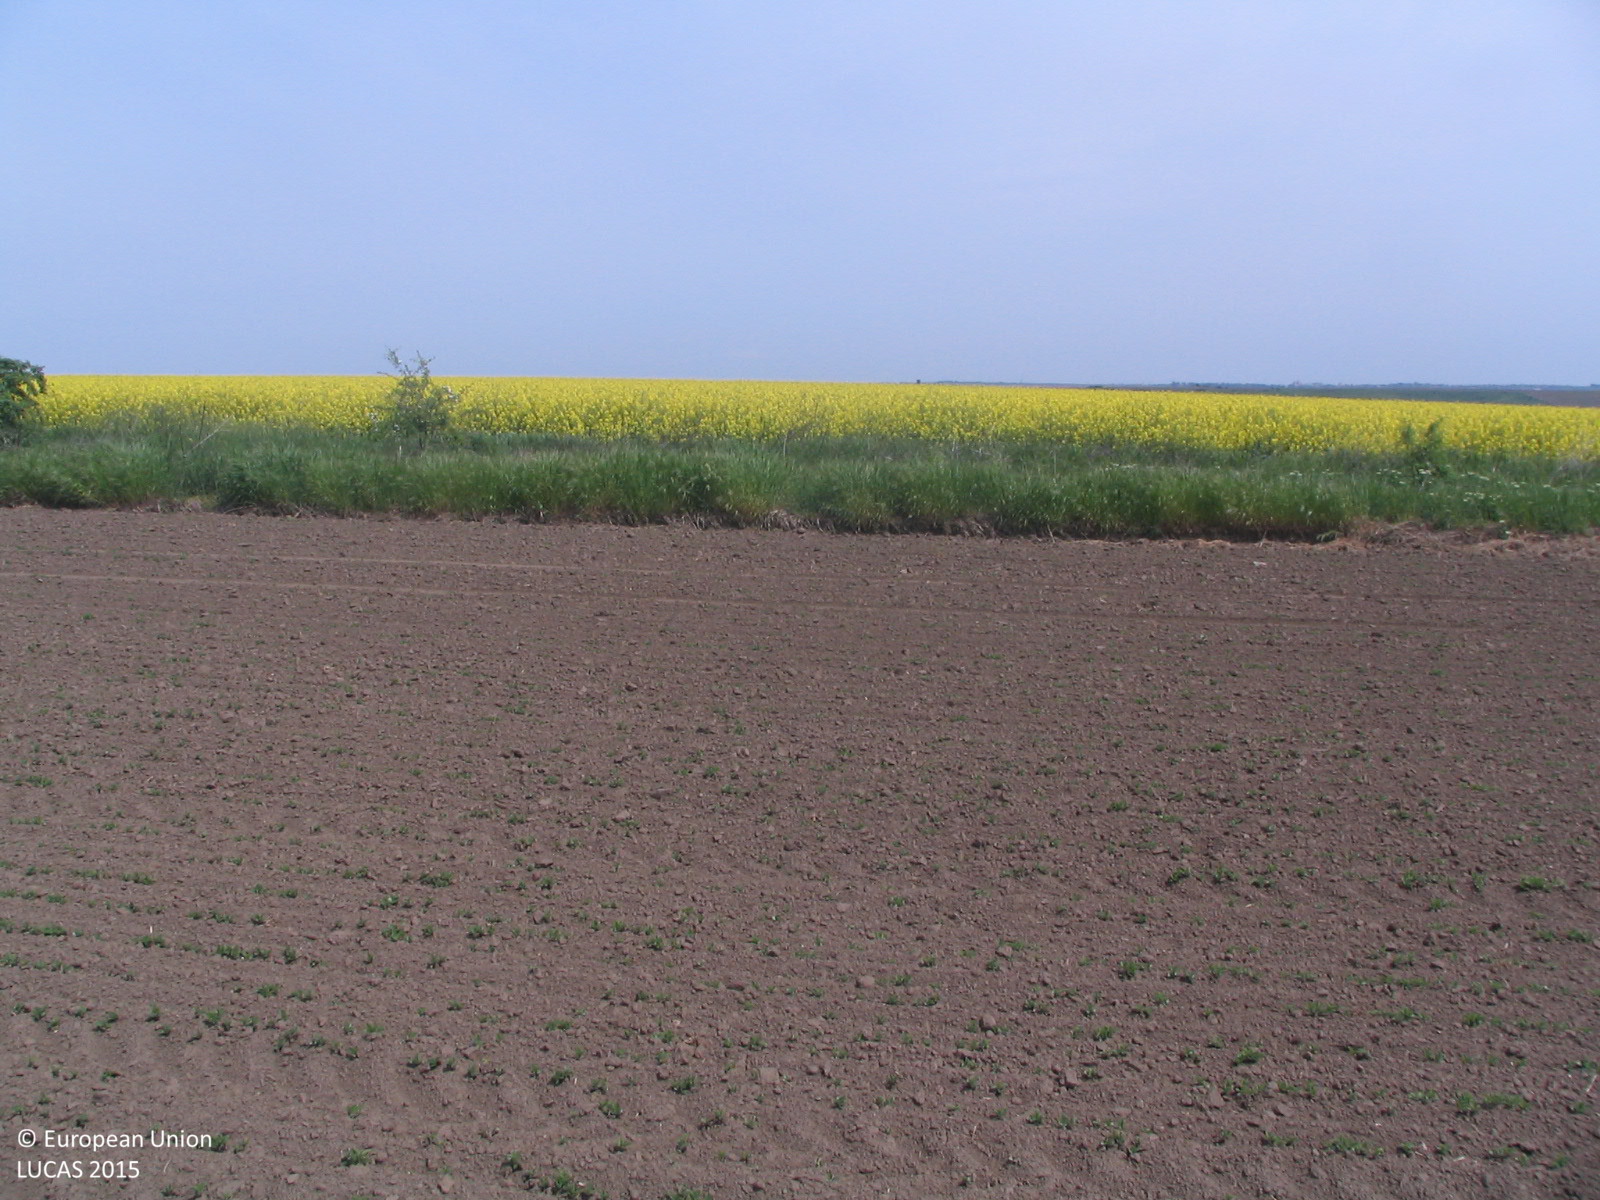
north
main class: Cropland
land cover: Soya
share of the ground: < 10 %
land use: Agriculture (excluding fallow land and kitchen gardens)
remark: Tilled/Sowed
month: May
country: BG
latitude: 43.6651
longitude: 23.9050
